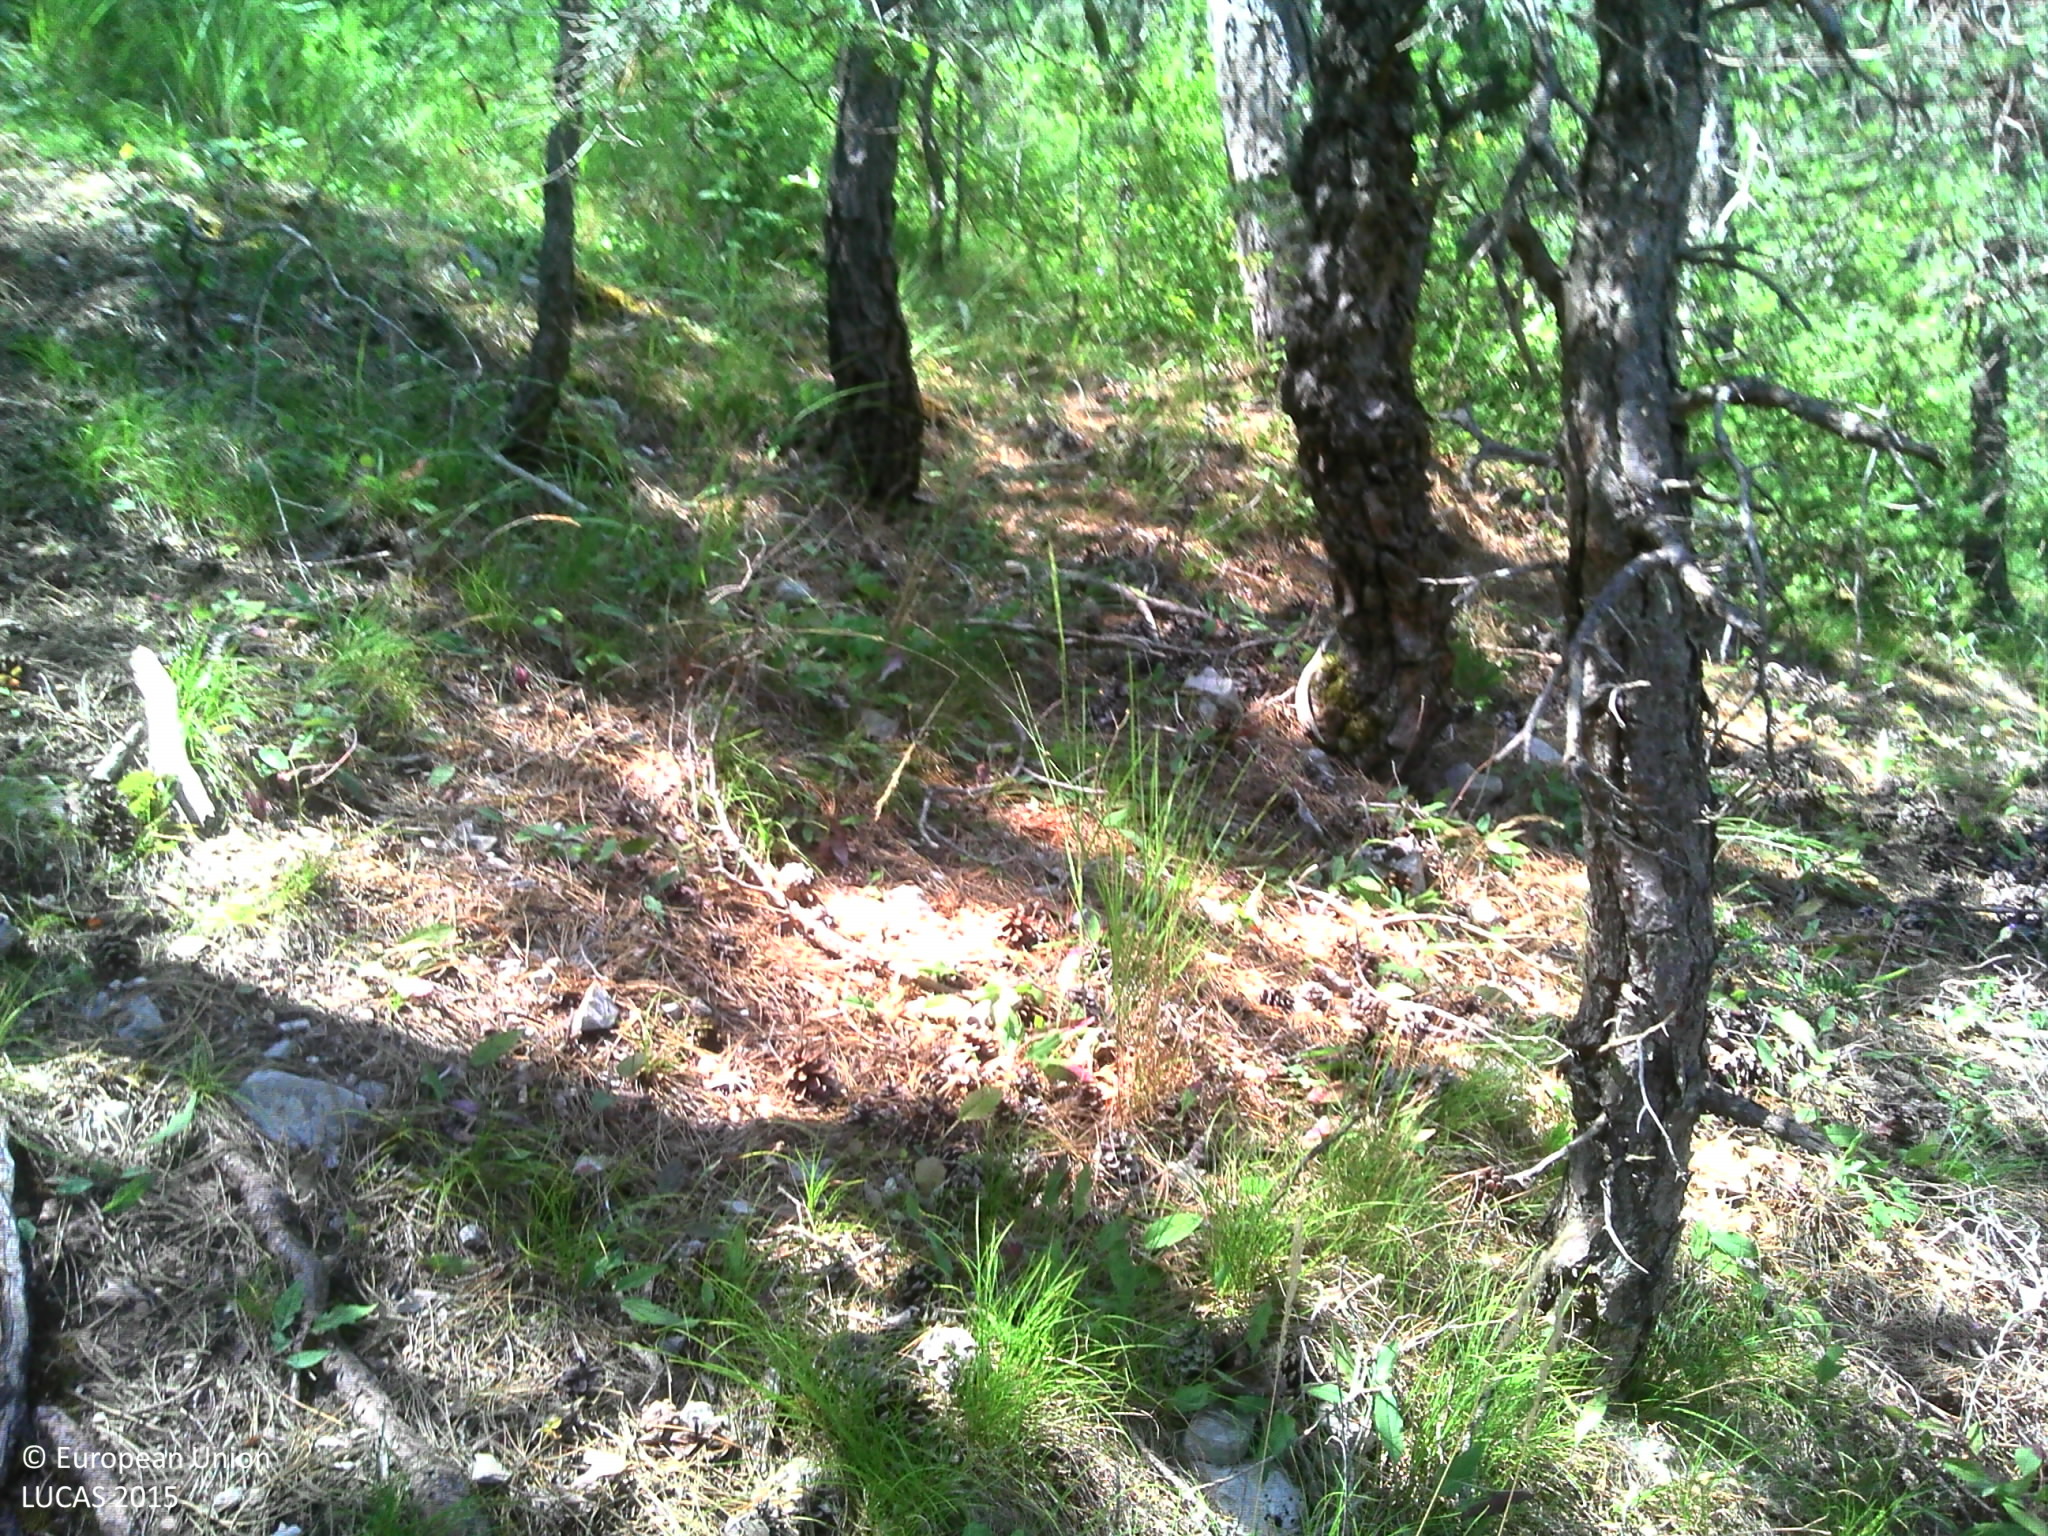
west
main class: Woodland
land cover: Pine dominated coniferous woodland
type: coniferous forest of the mediterranean region
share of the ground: > 75 %
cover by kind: coniferous forest trees 100 %
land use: Forestry
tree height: > 5 m
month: July
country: FR
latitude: 44.8047
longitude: 5.3157
